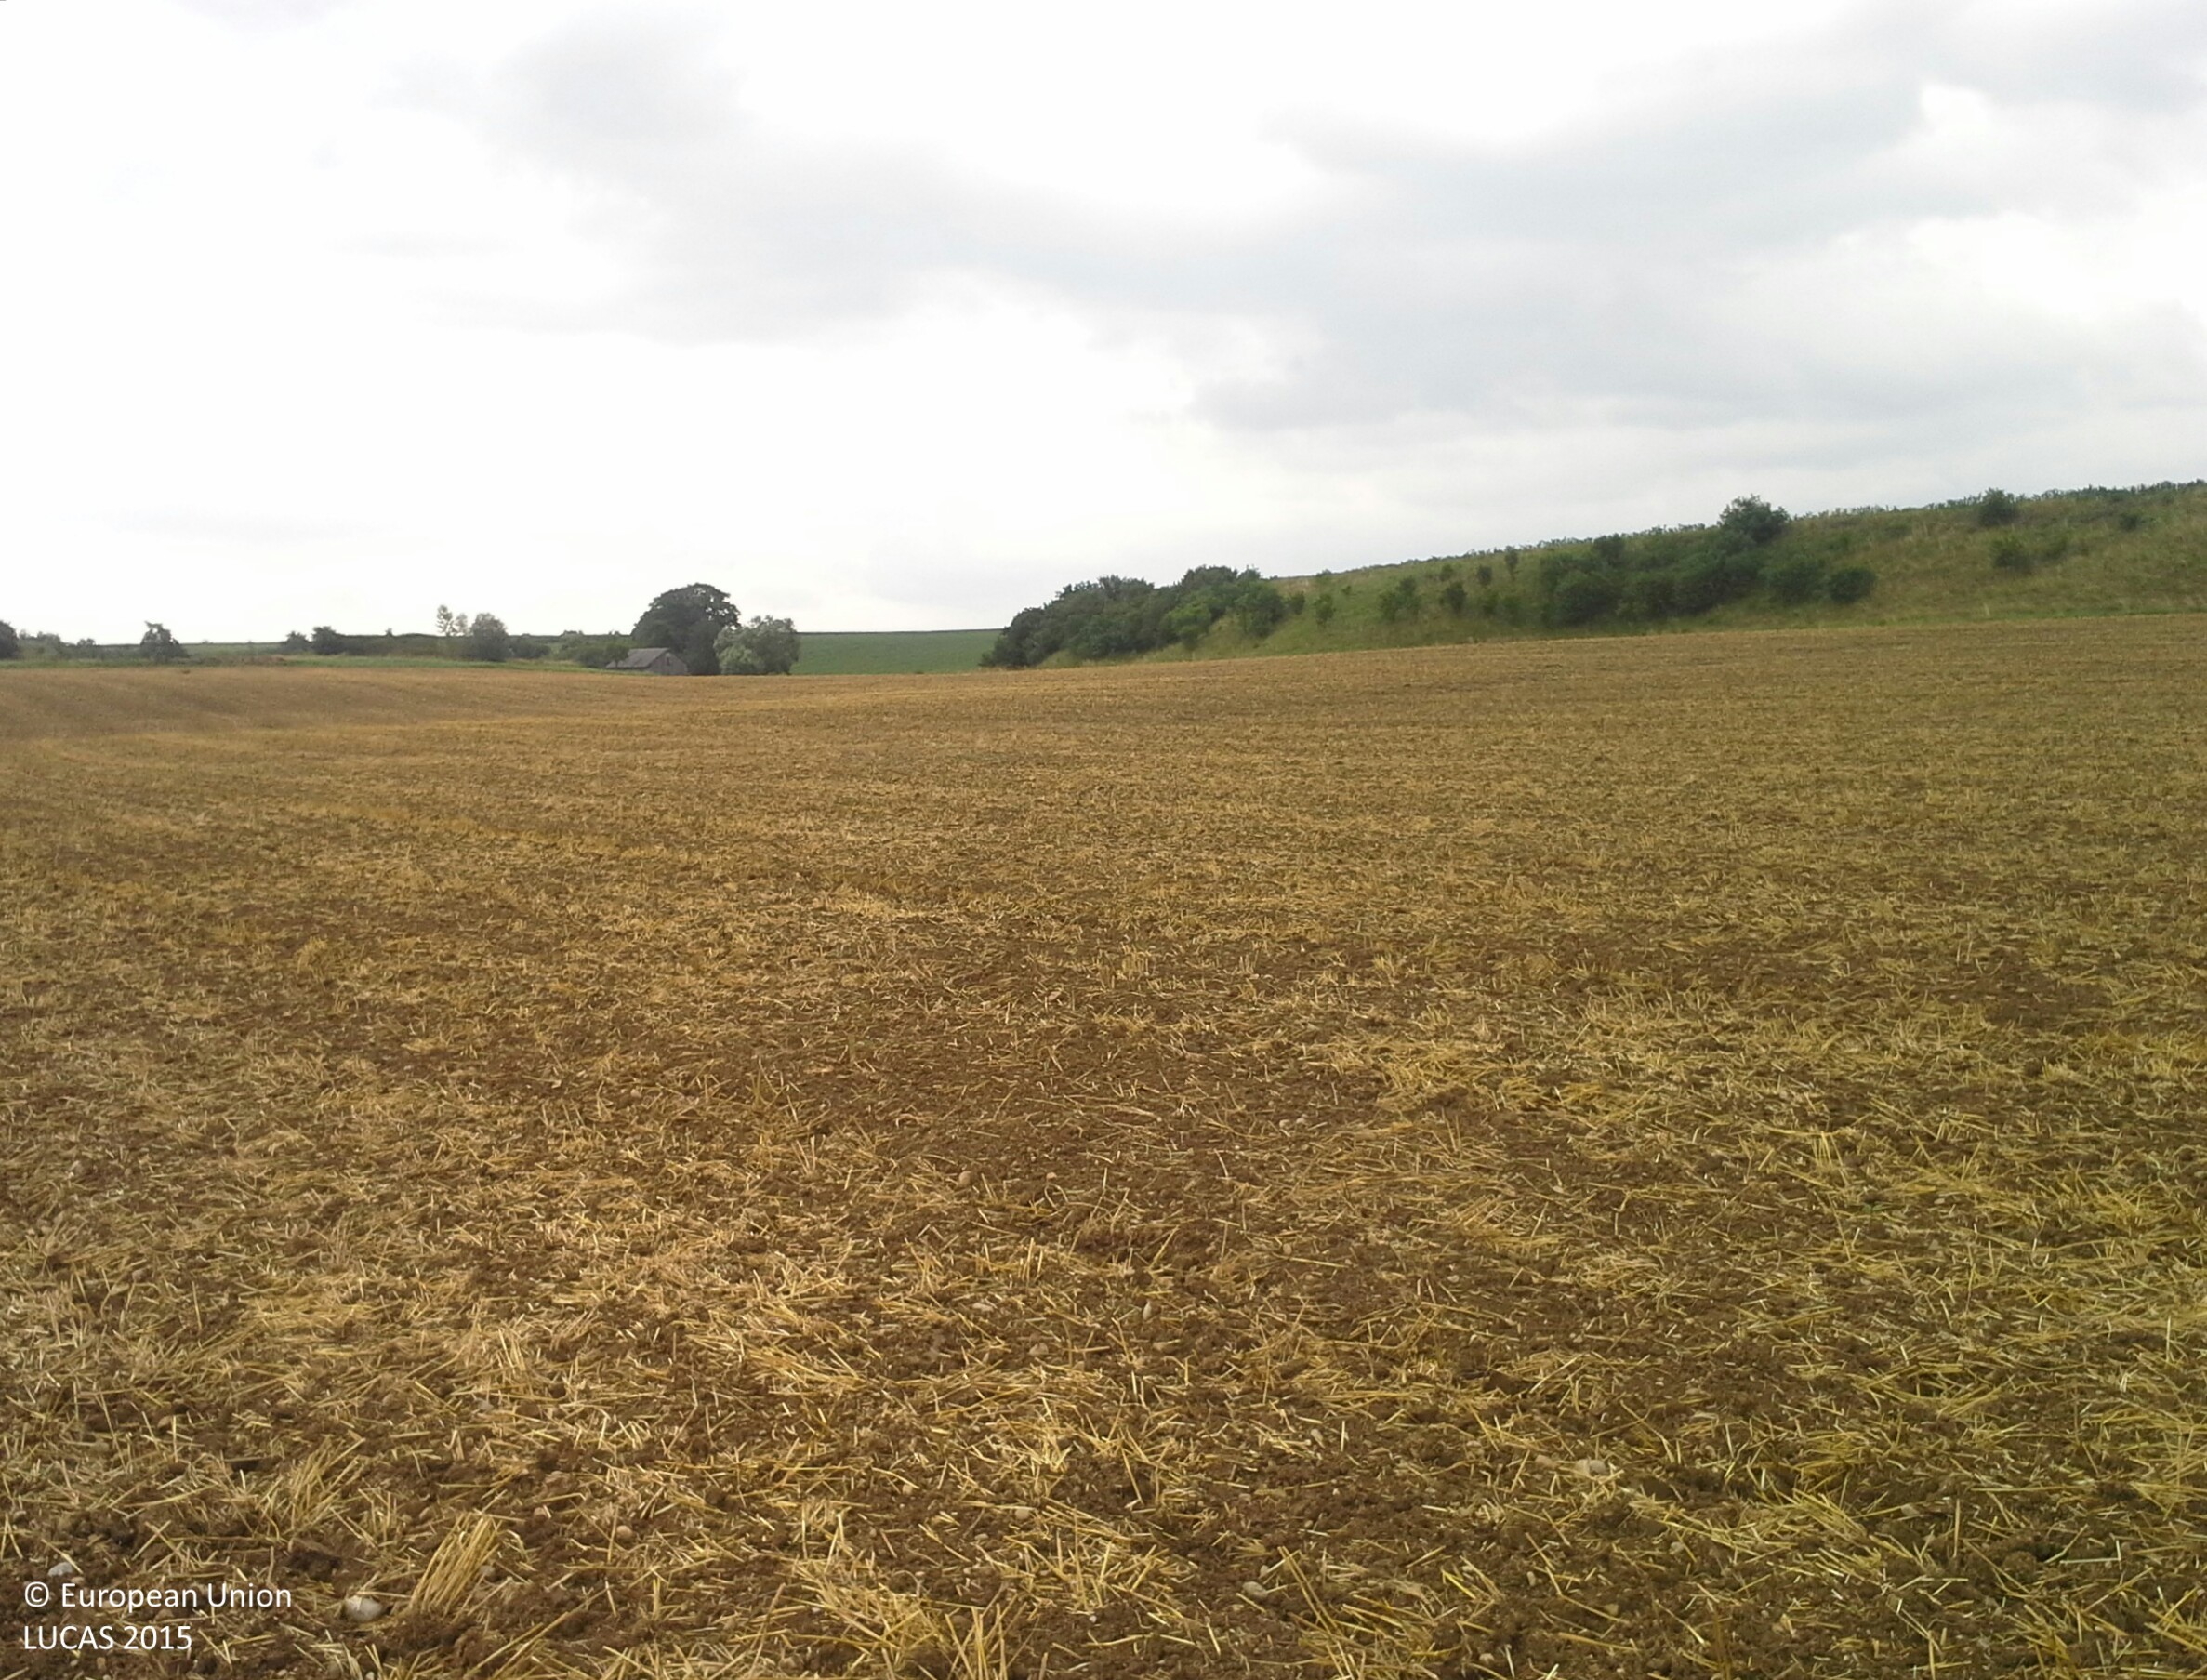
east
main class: Cropland
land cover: Barley
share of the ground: 10 - 25 %
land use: Agriculture (excluding fallow land and kitchen gardens)
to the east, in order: Barley
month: July
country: AT
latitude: 48.0630
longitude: 14.8449
